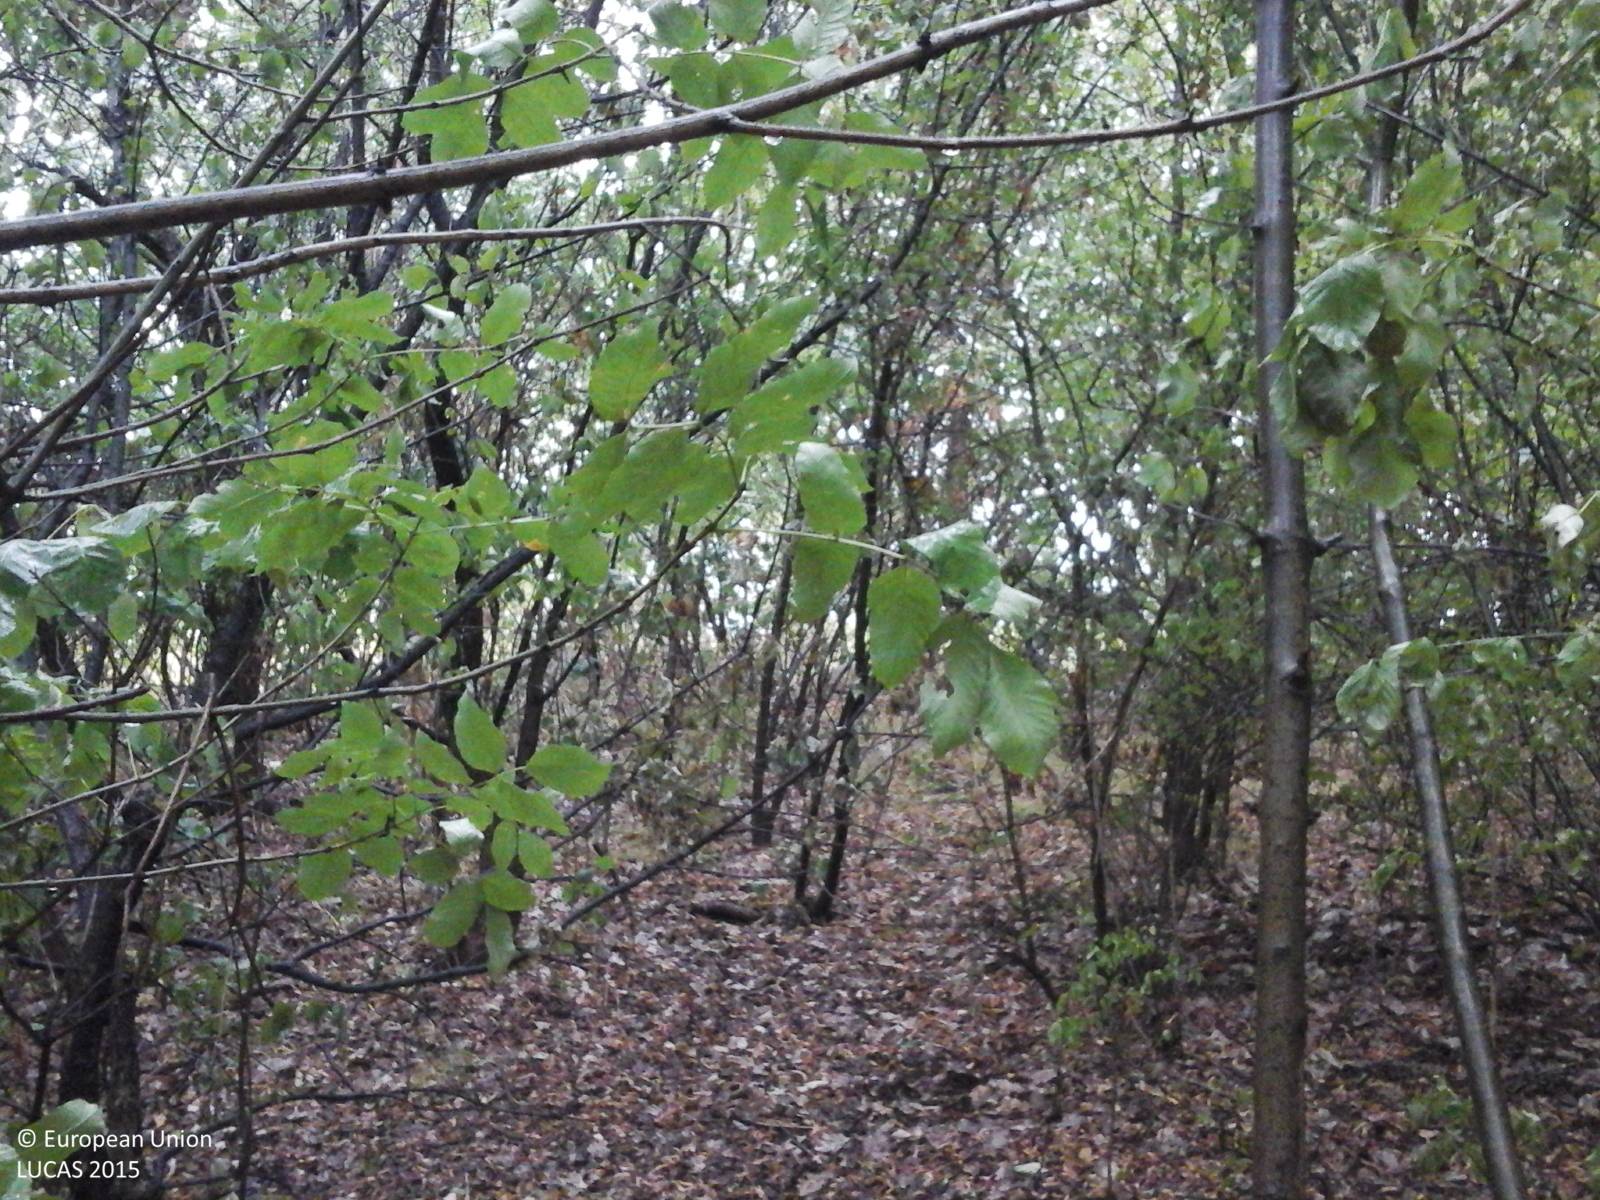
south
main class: Woodland
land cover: Broadleaved woodland
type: mesophytic deciduous forest
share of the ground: > 75 %
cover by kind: broadleaved forest trees 100 %
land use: Forestry
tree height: > 5 m
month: August
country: RO
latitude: 44.7152
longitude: 22.7041
